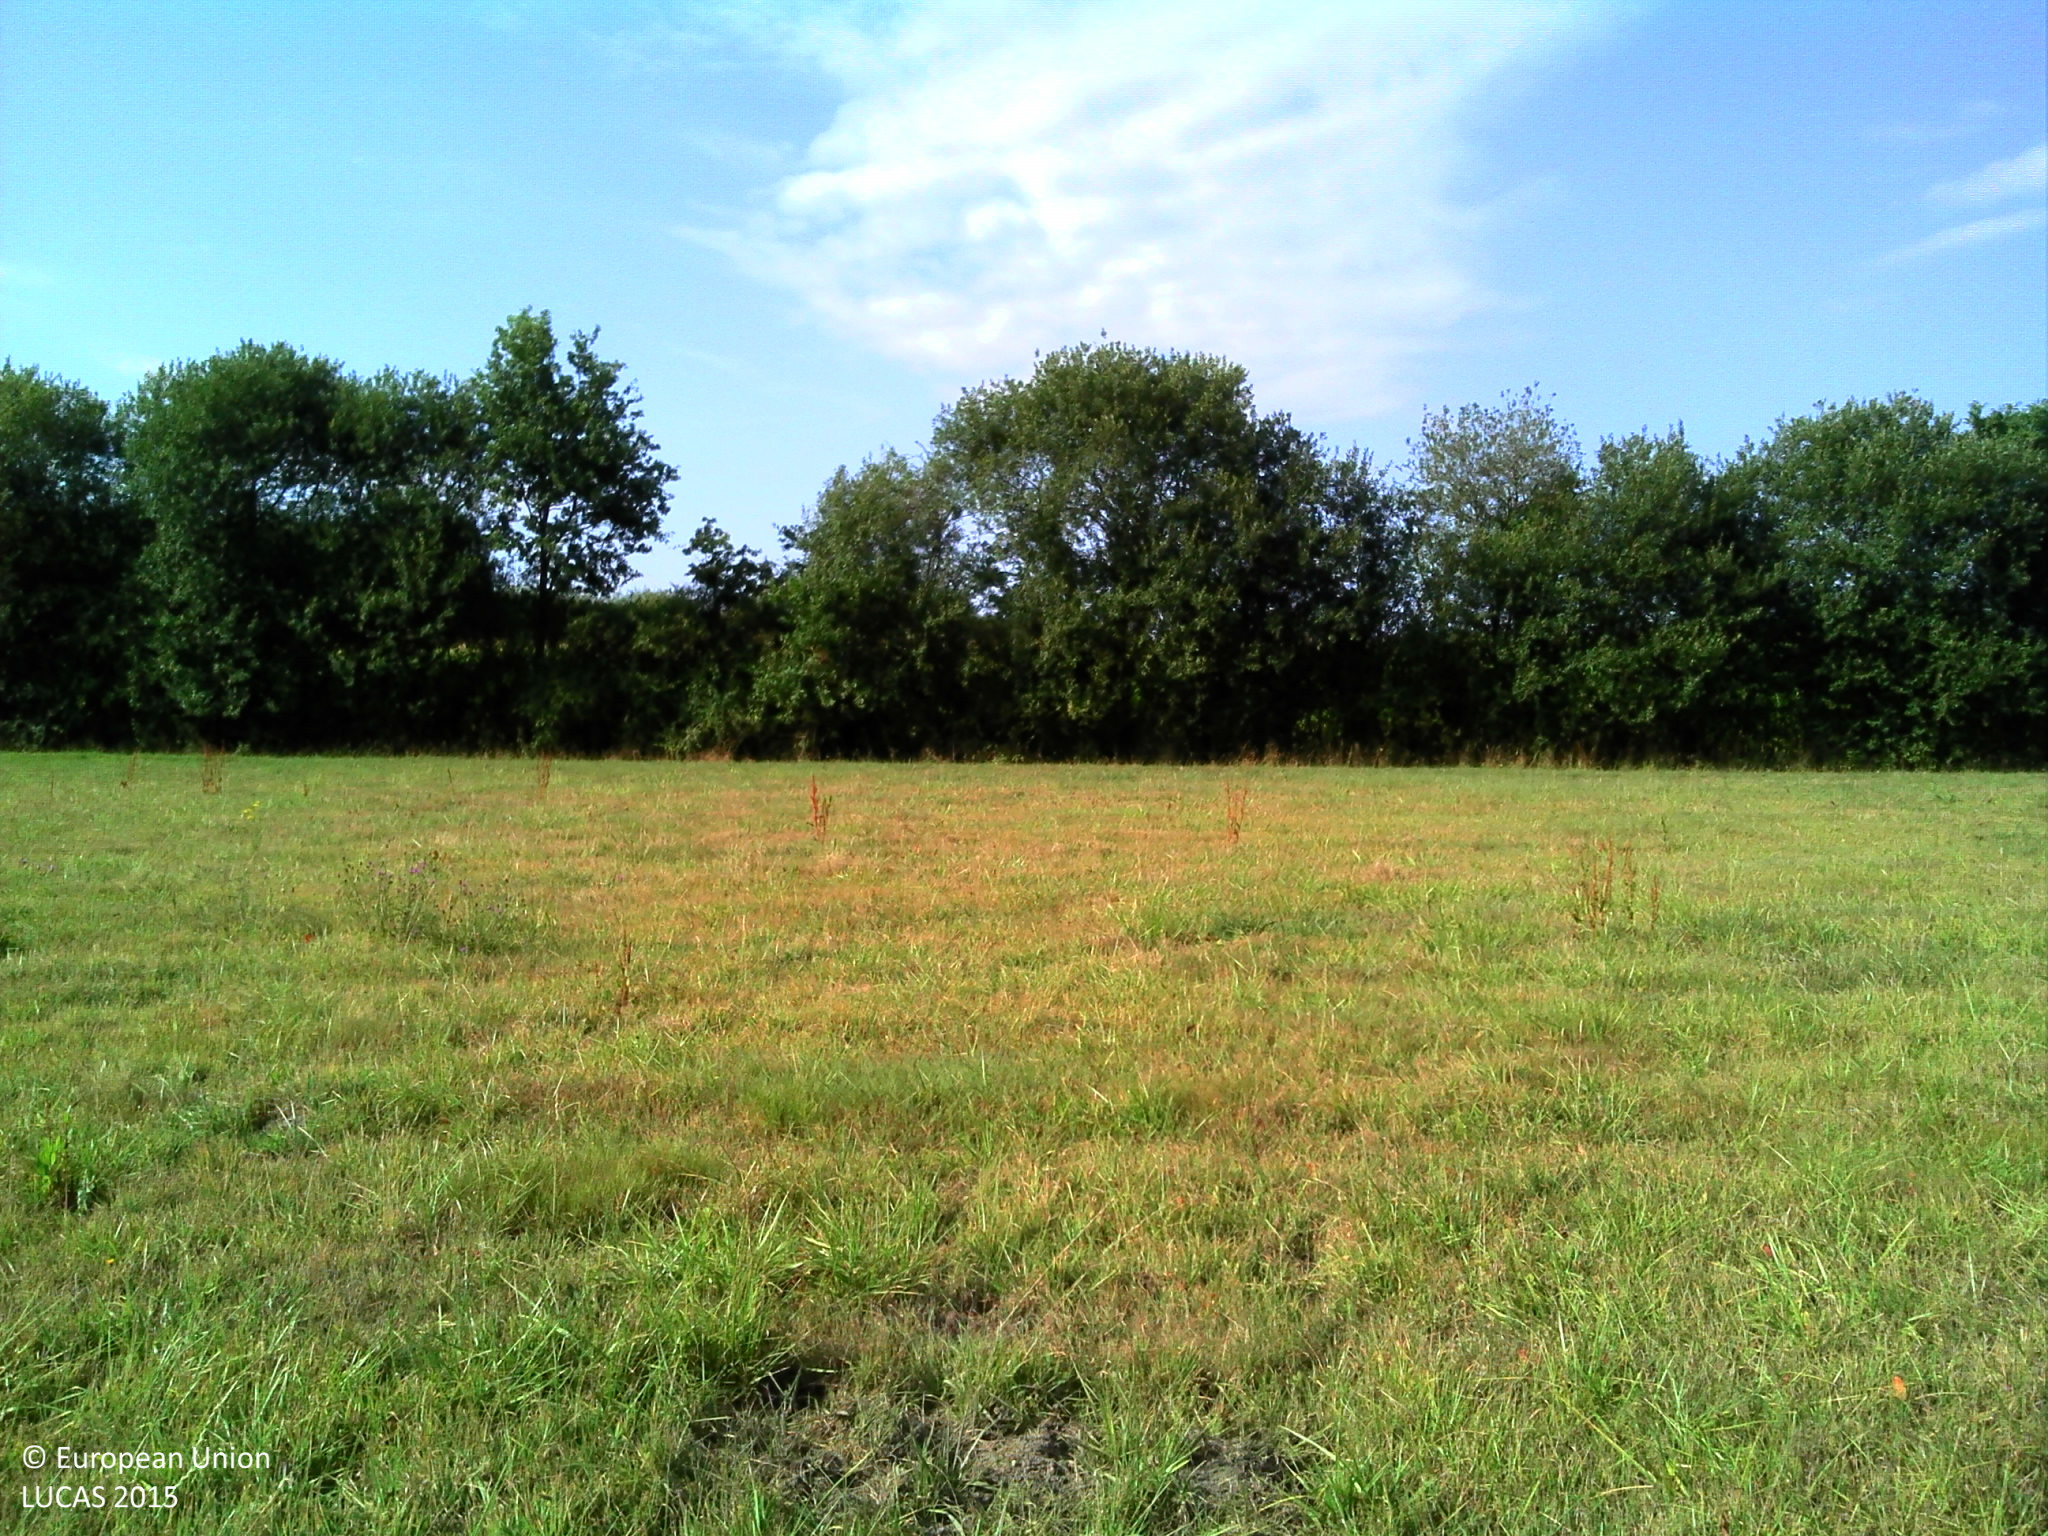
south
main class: Cropland
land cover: Temporary grasslands
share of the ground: > 75 %
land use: Agriculture (excluding fallow land and kitchen gardens)
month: August
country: FR
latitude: 47.4409
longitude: -1.8086
